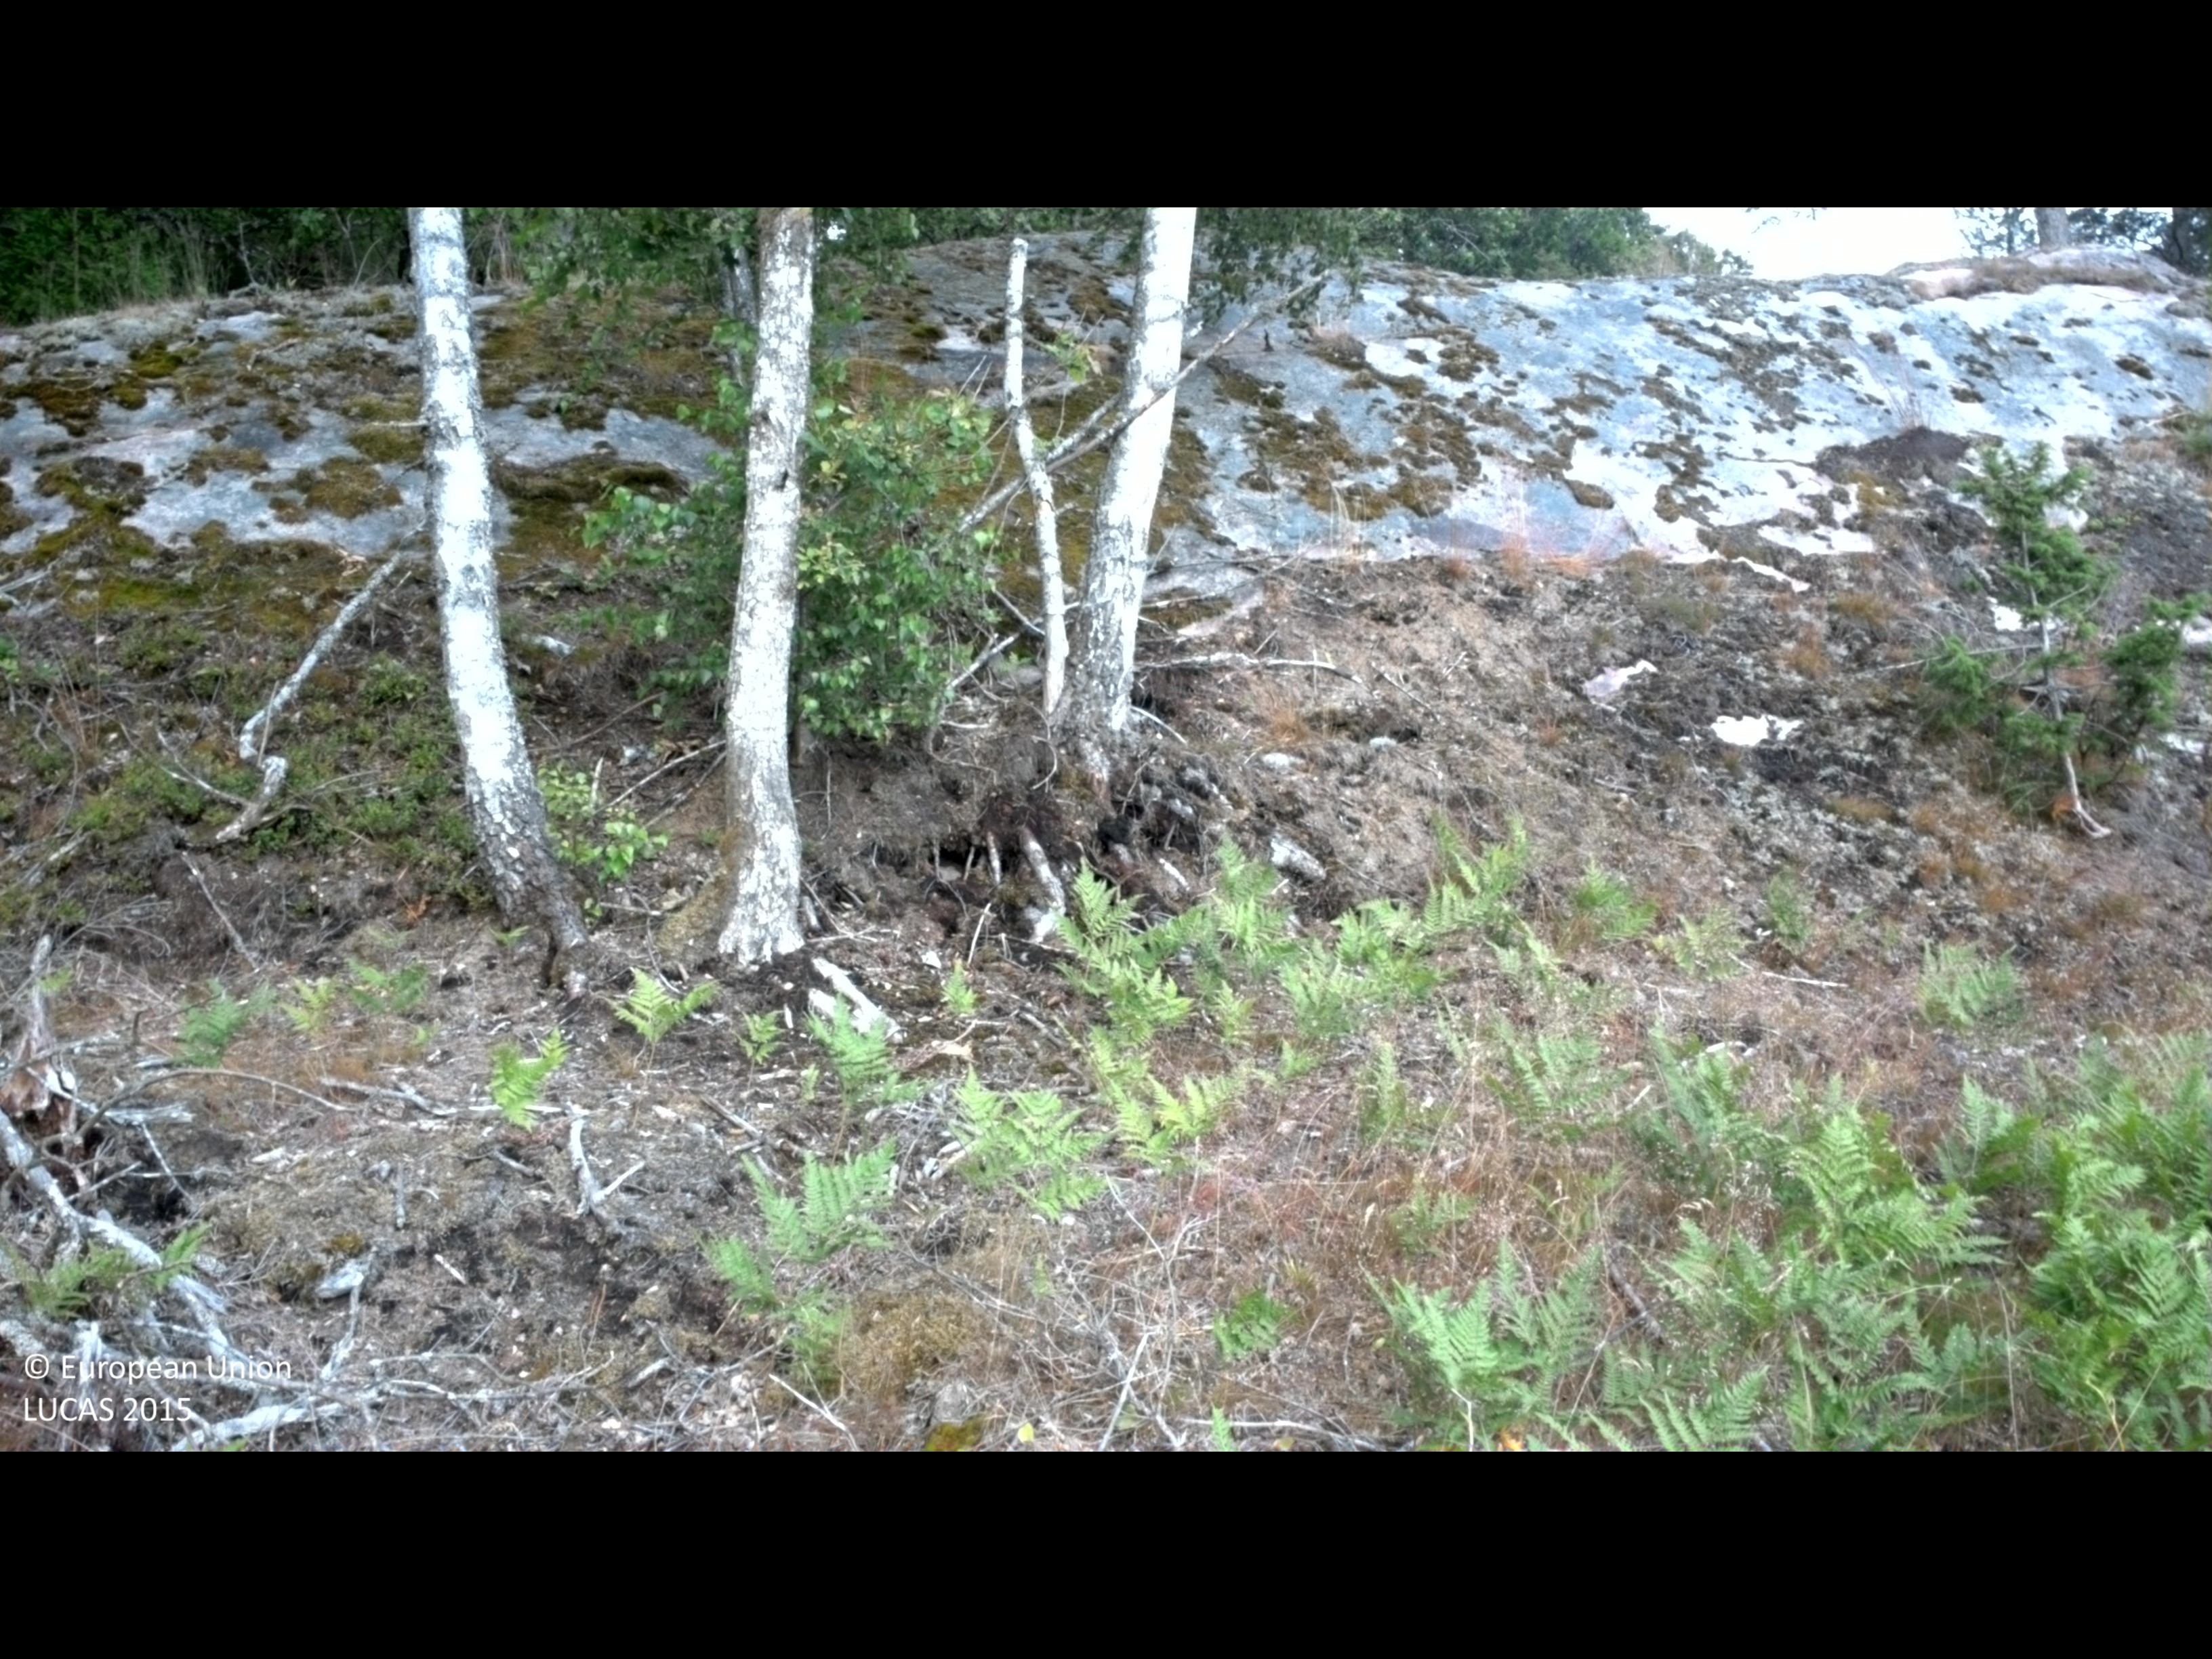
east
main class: Woodland
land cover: Broadleaved woodland
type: boreal forest
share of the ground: 10 - 25 %
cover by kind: herbaceous plants 60 %, broadleaved forest trees 20 %, shrubs 10 %, lichens and mosses 10 %
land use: Forestry
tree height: < 5 m
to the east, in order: Broadleaved woodland; Rocks and stones; Broadleaved woodland; Spruce dominated coniferous woodland; Ditches and canals; Paved roads, cycling and walking lanes; Grass margins; Grassland without tree/shrub cover; Electric lines; Broadleaved woodland; Shrubland with sparse tree cover
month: July
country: SE
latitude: 58.1051
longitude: 16.3604
